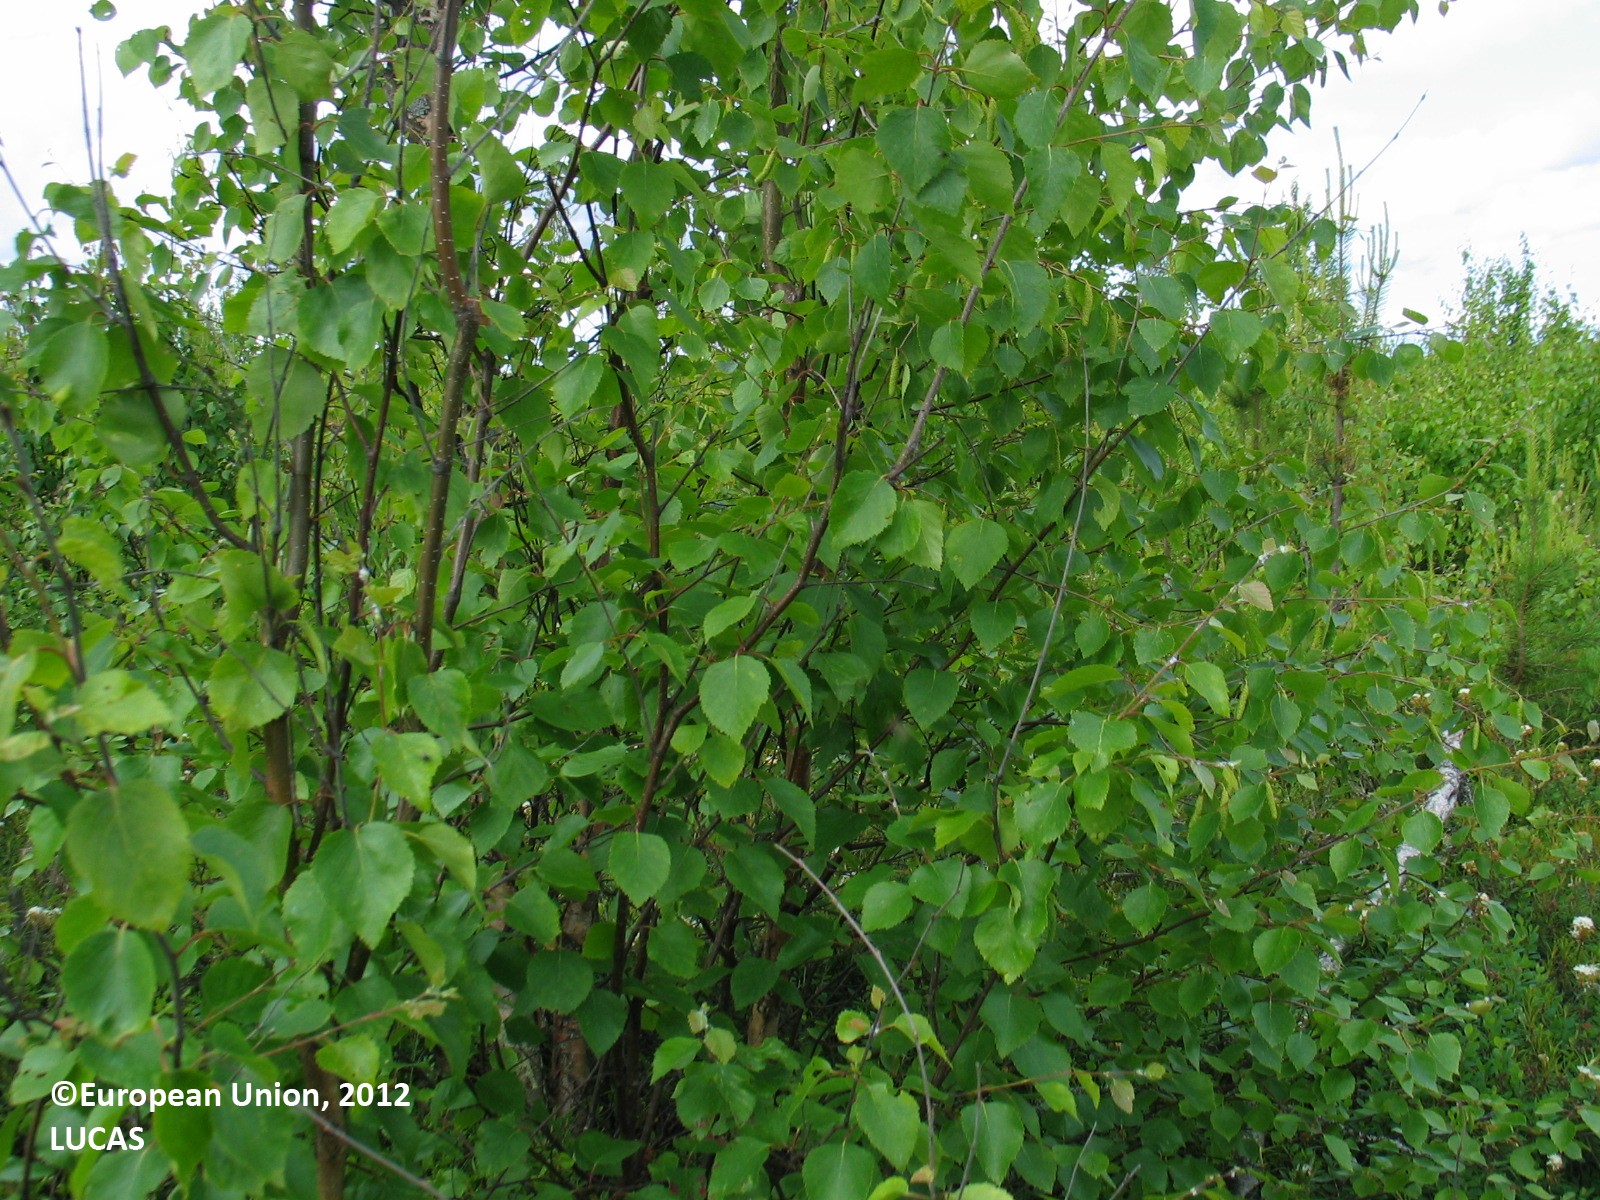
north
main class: Woodland
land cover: Other mixed woodland
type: boreal forest
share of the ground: 25 - 50 %
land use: Forestry
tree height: < 5 m
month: June
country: FI
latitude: 64.8346
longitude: 26.5729
